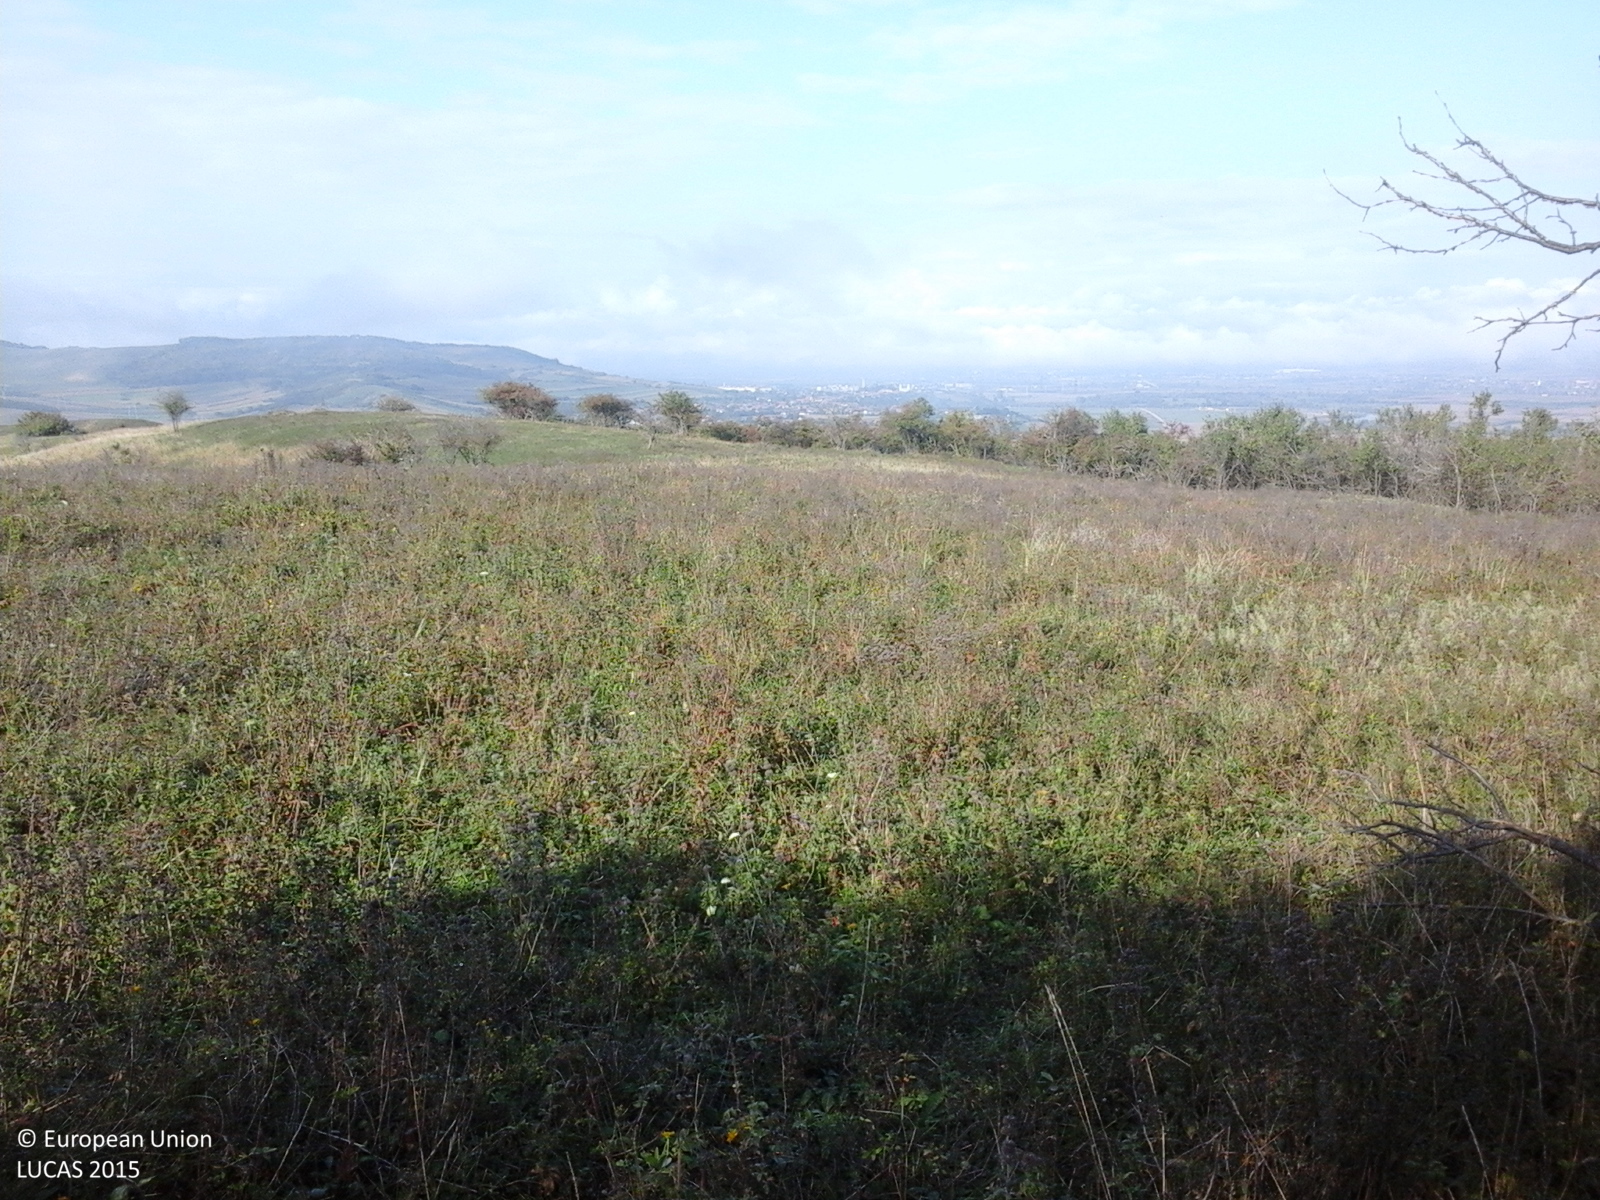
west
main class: Shrubland
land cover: Shrubland without tree cover
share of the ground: > 75 %
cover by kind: shrubs 100 %
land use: Semi-natural and natural areas not in use
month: October
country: RO
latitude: 46.3851
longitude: 23.9227
